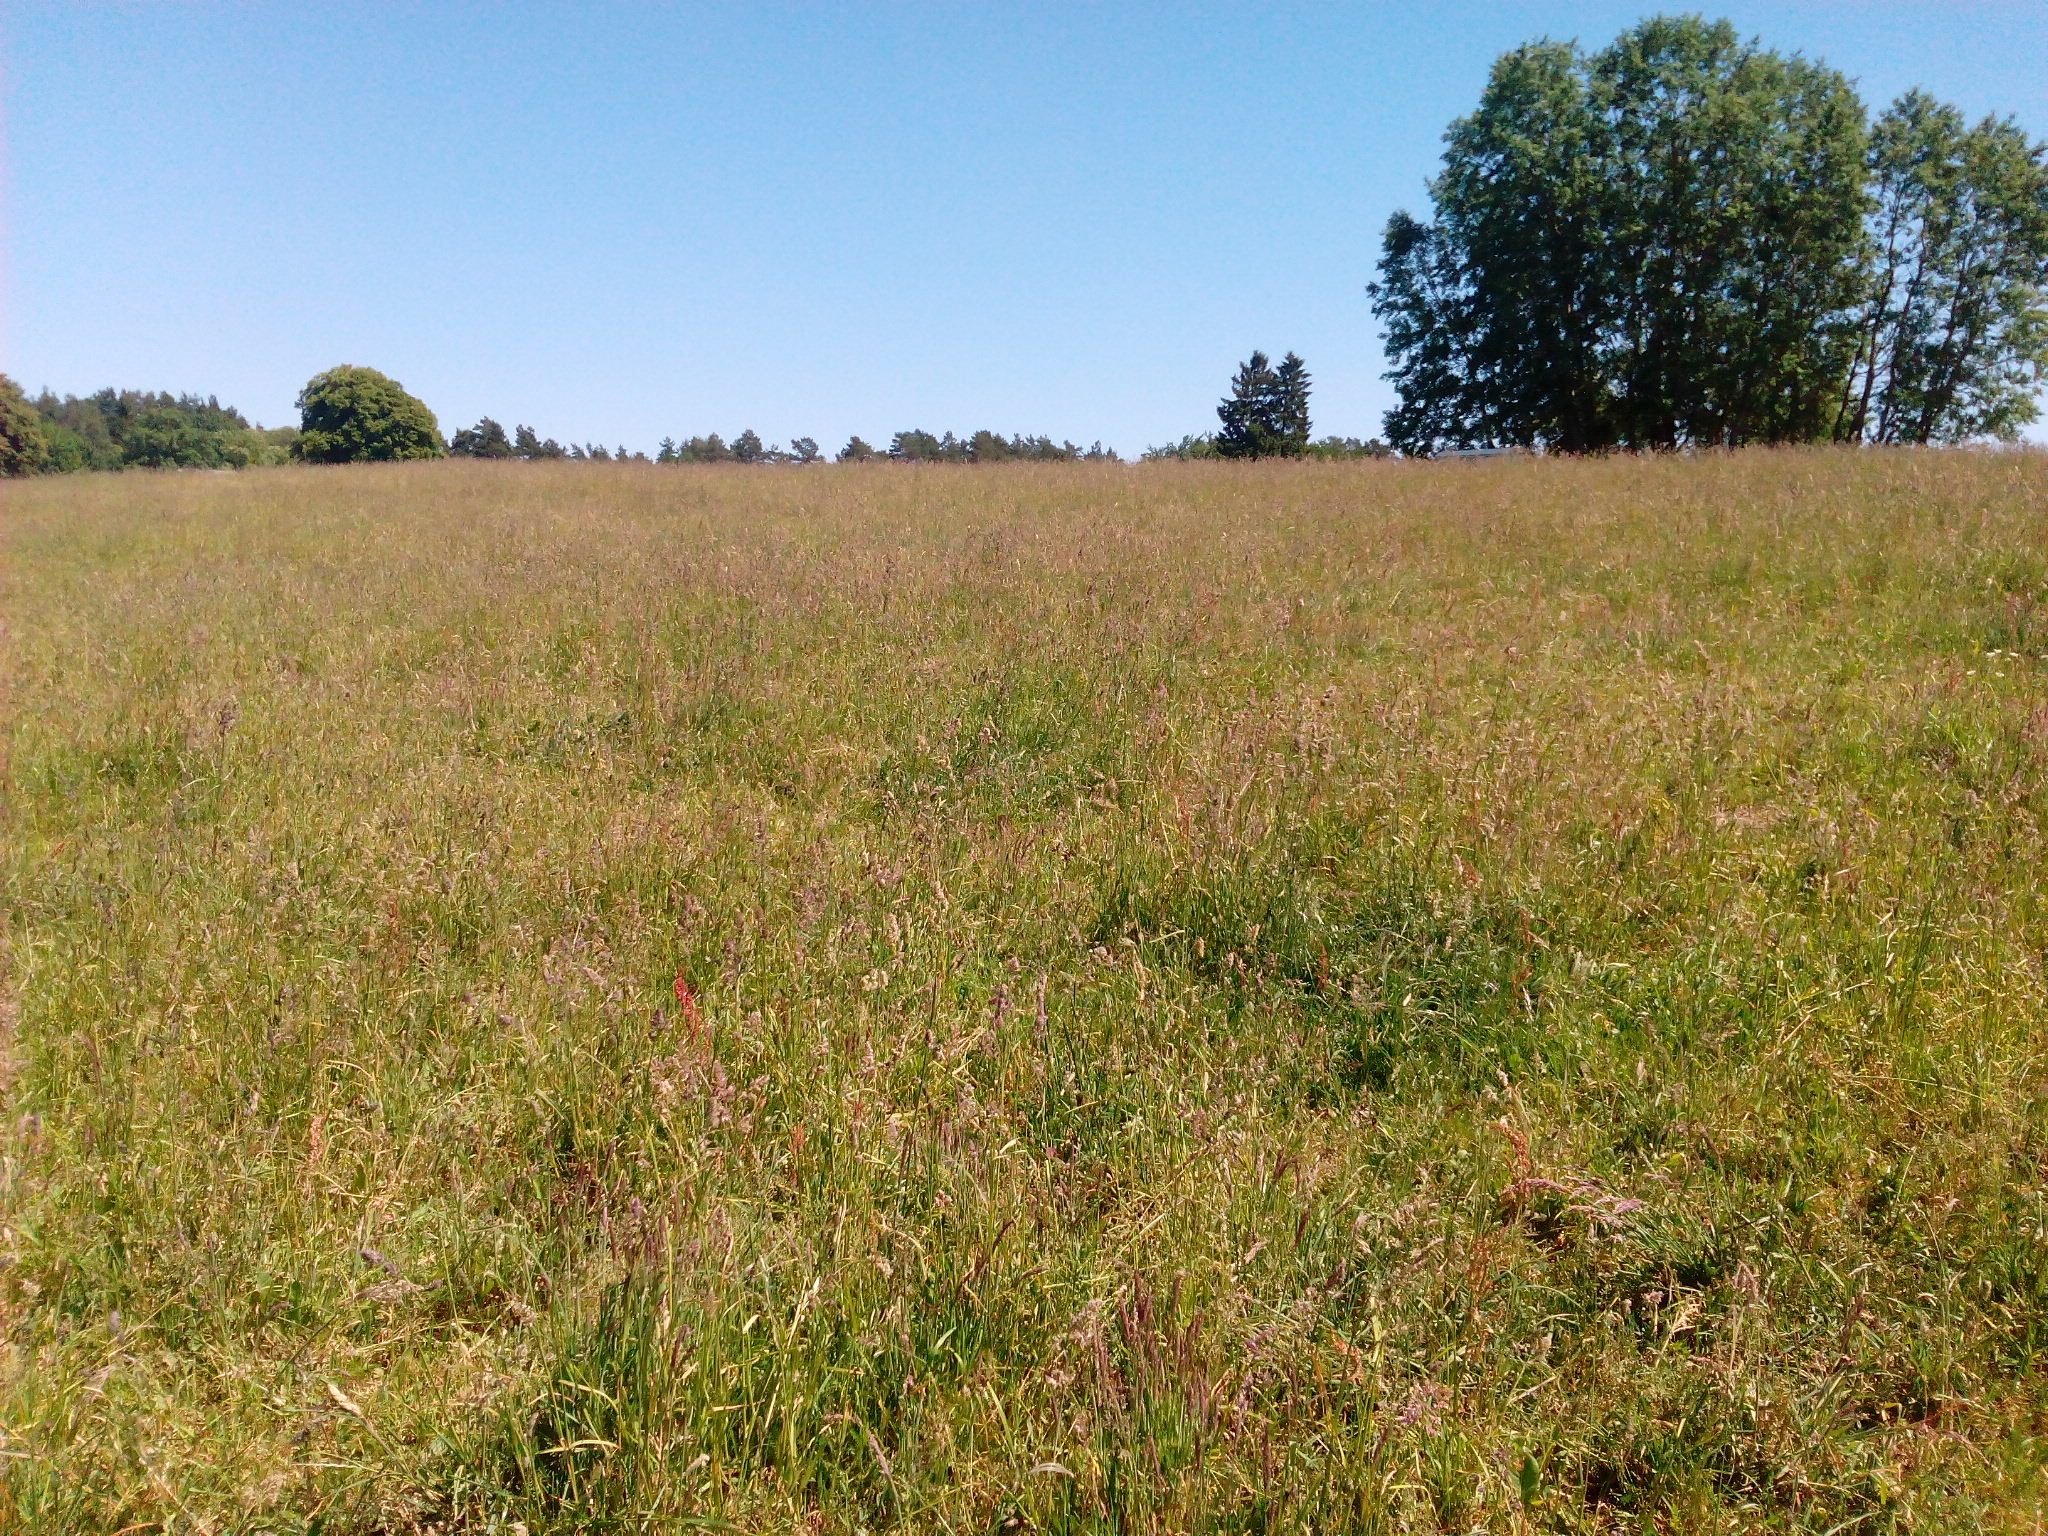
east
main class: Grassland
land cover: Grassland without tree/shrub cover
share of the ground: > 75 %
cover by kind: herbaceous plants 95 %, shrubs 5 %
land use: Agriculture (excluding fallow land and kitchen gardens)
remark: Harvested field
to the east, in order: Grassland without tree/shrub cover; Fences; Tracks; Grassland without tree/shrub cover
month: June
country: DE
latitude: 53.1693
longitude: 13.5753
